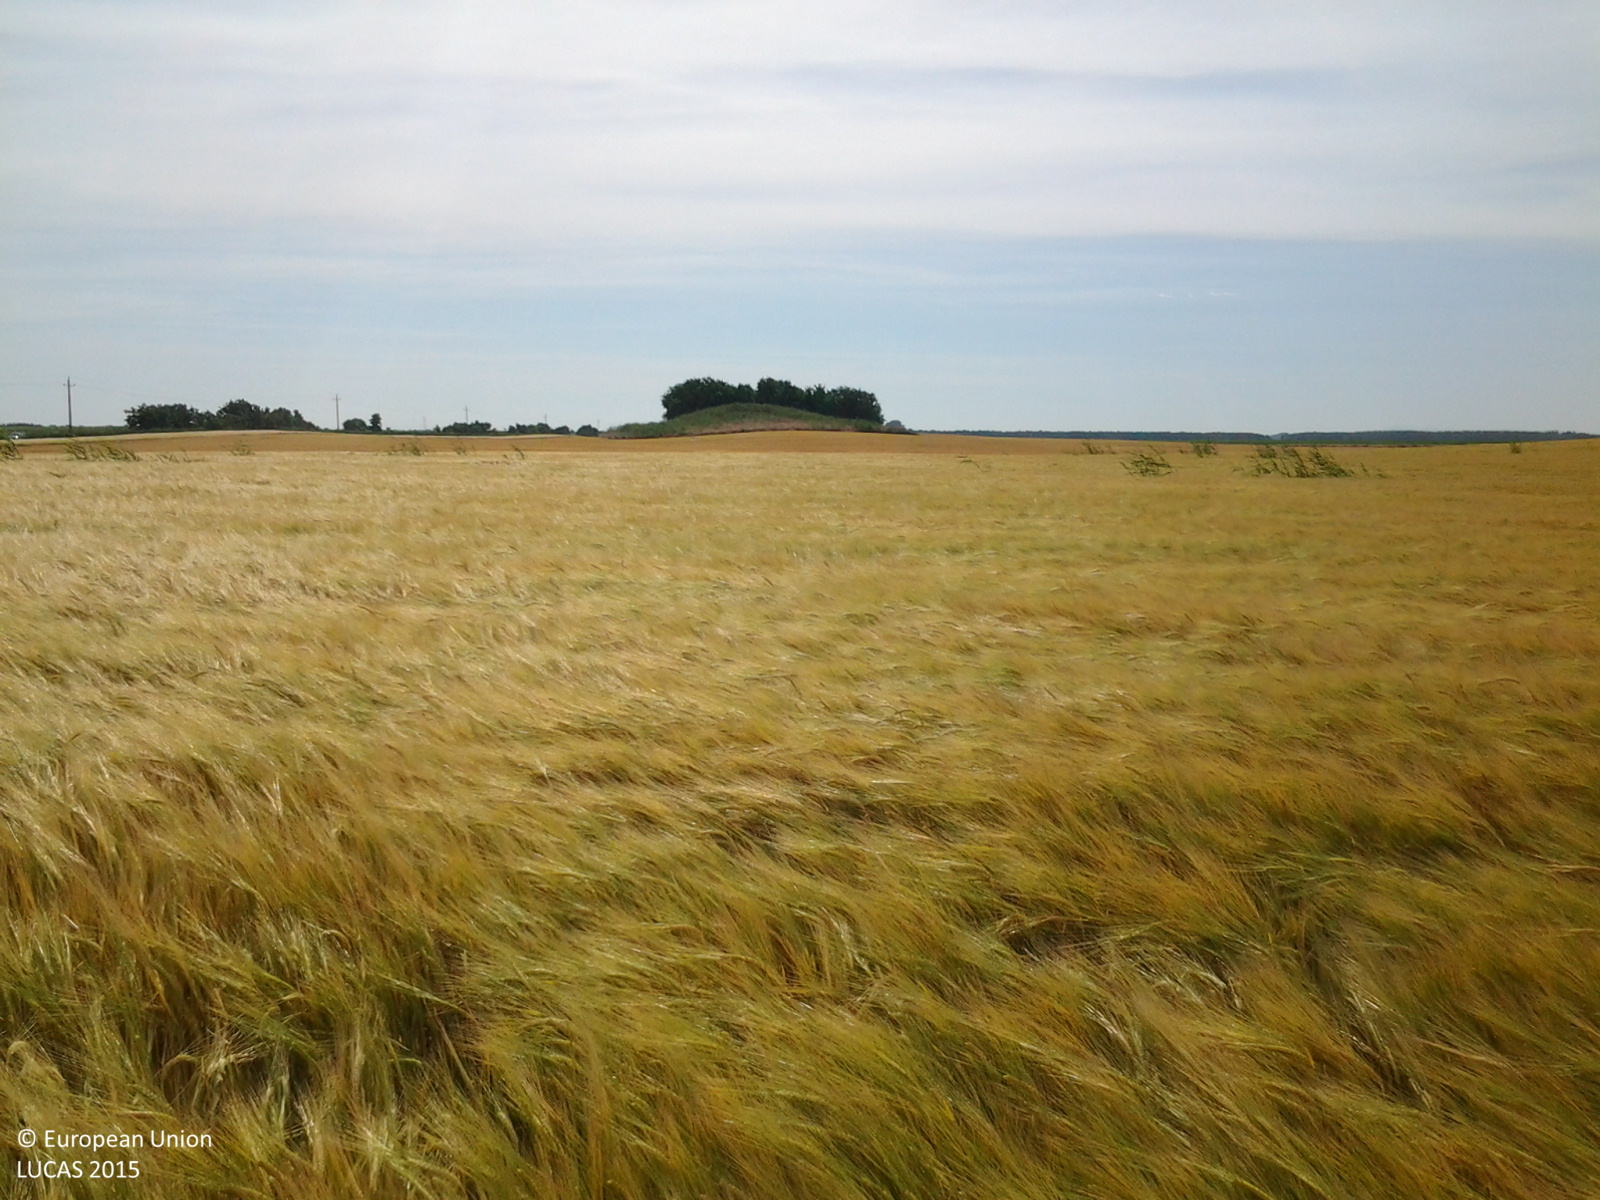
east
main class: Cropland
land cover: Barley
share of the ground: > 75 %
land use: Agriculture (excluding fallow land and kitchen gardens)
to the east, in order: Barley
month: June
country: HU
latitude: 46.4731
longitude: 21.1691
